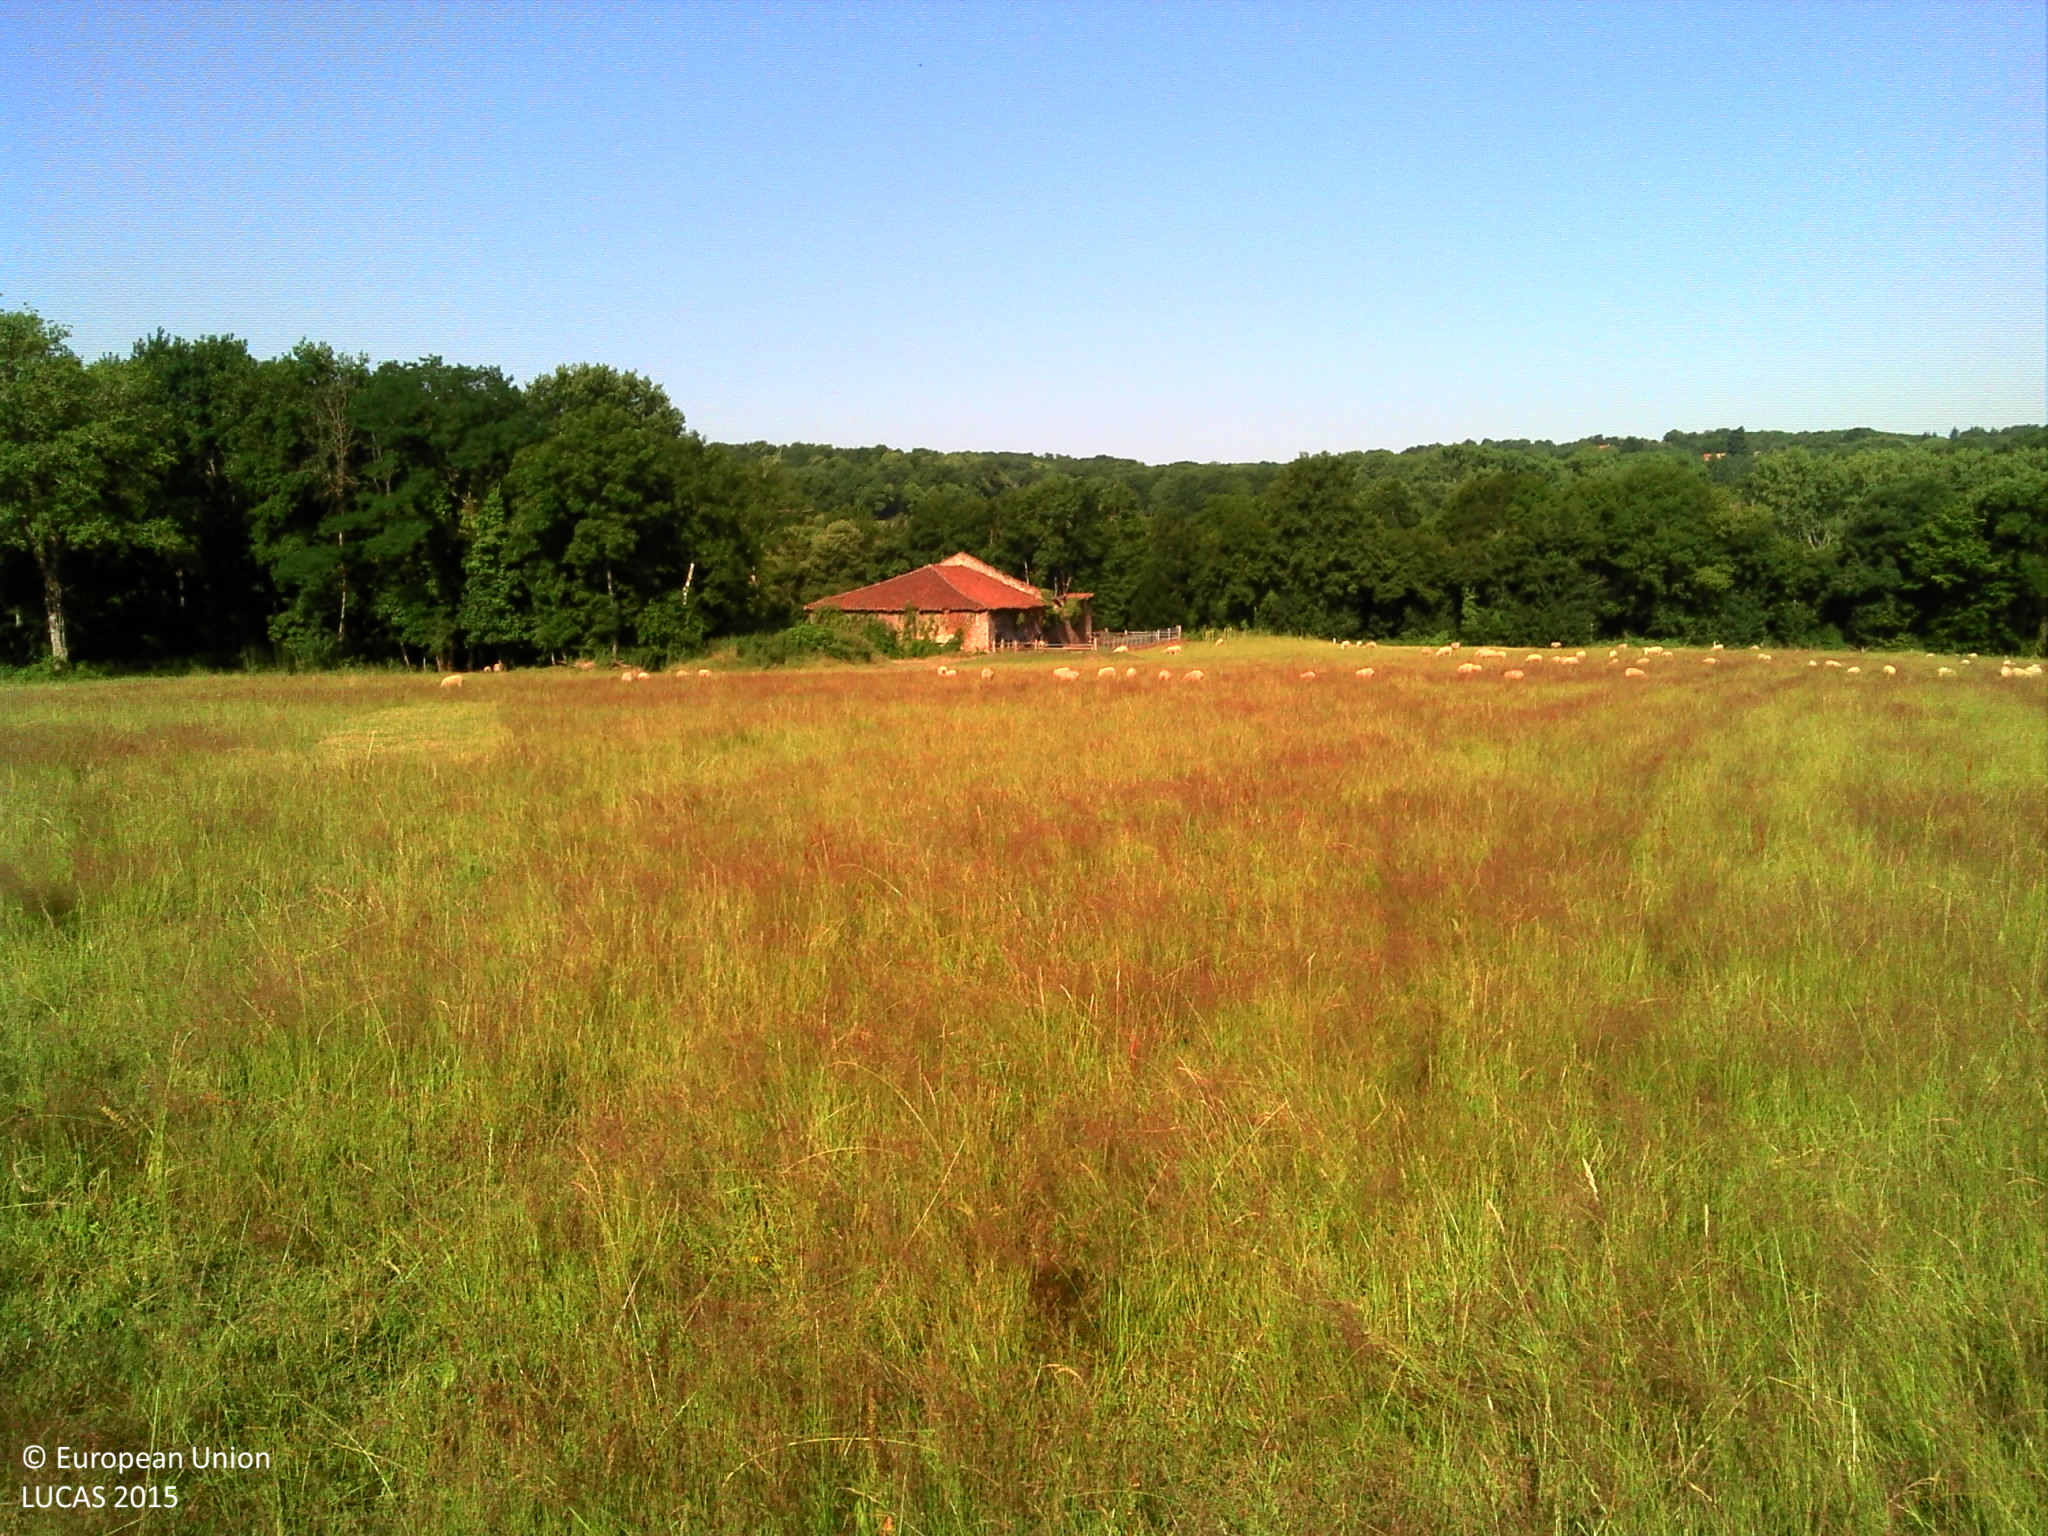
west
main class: Grassland
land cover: Grassland without tree/shrub cover
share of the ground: > 75 %
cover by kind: herbaceous plants 100 %
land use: Agriculture (excluding fallow land and kitchen gardens)
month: June
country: FR
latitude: 45.9217
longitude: 0.6378
